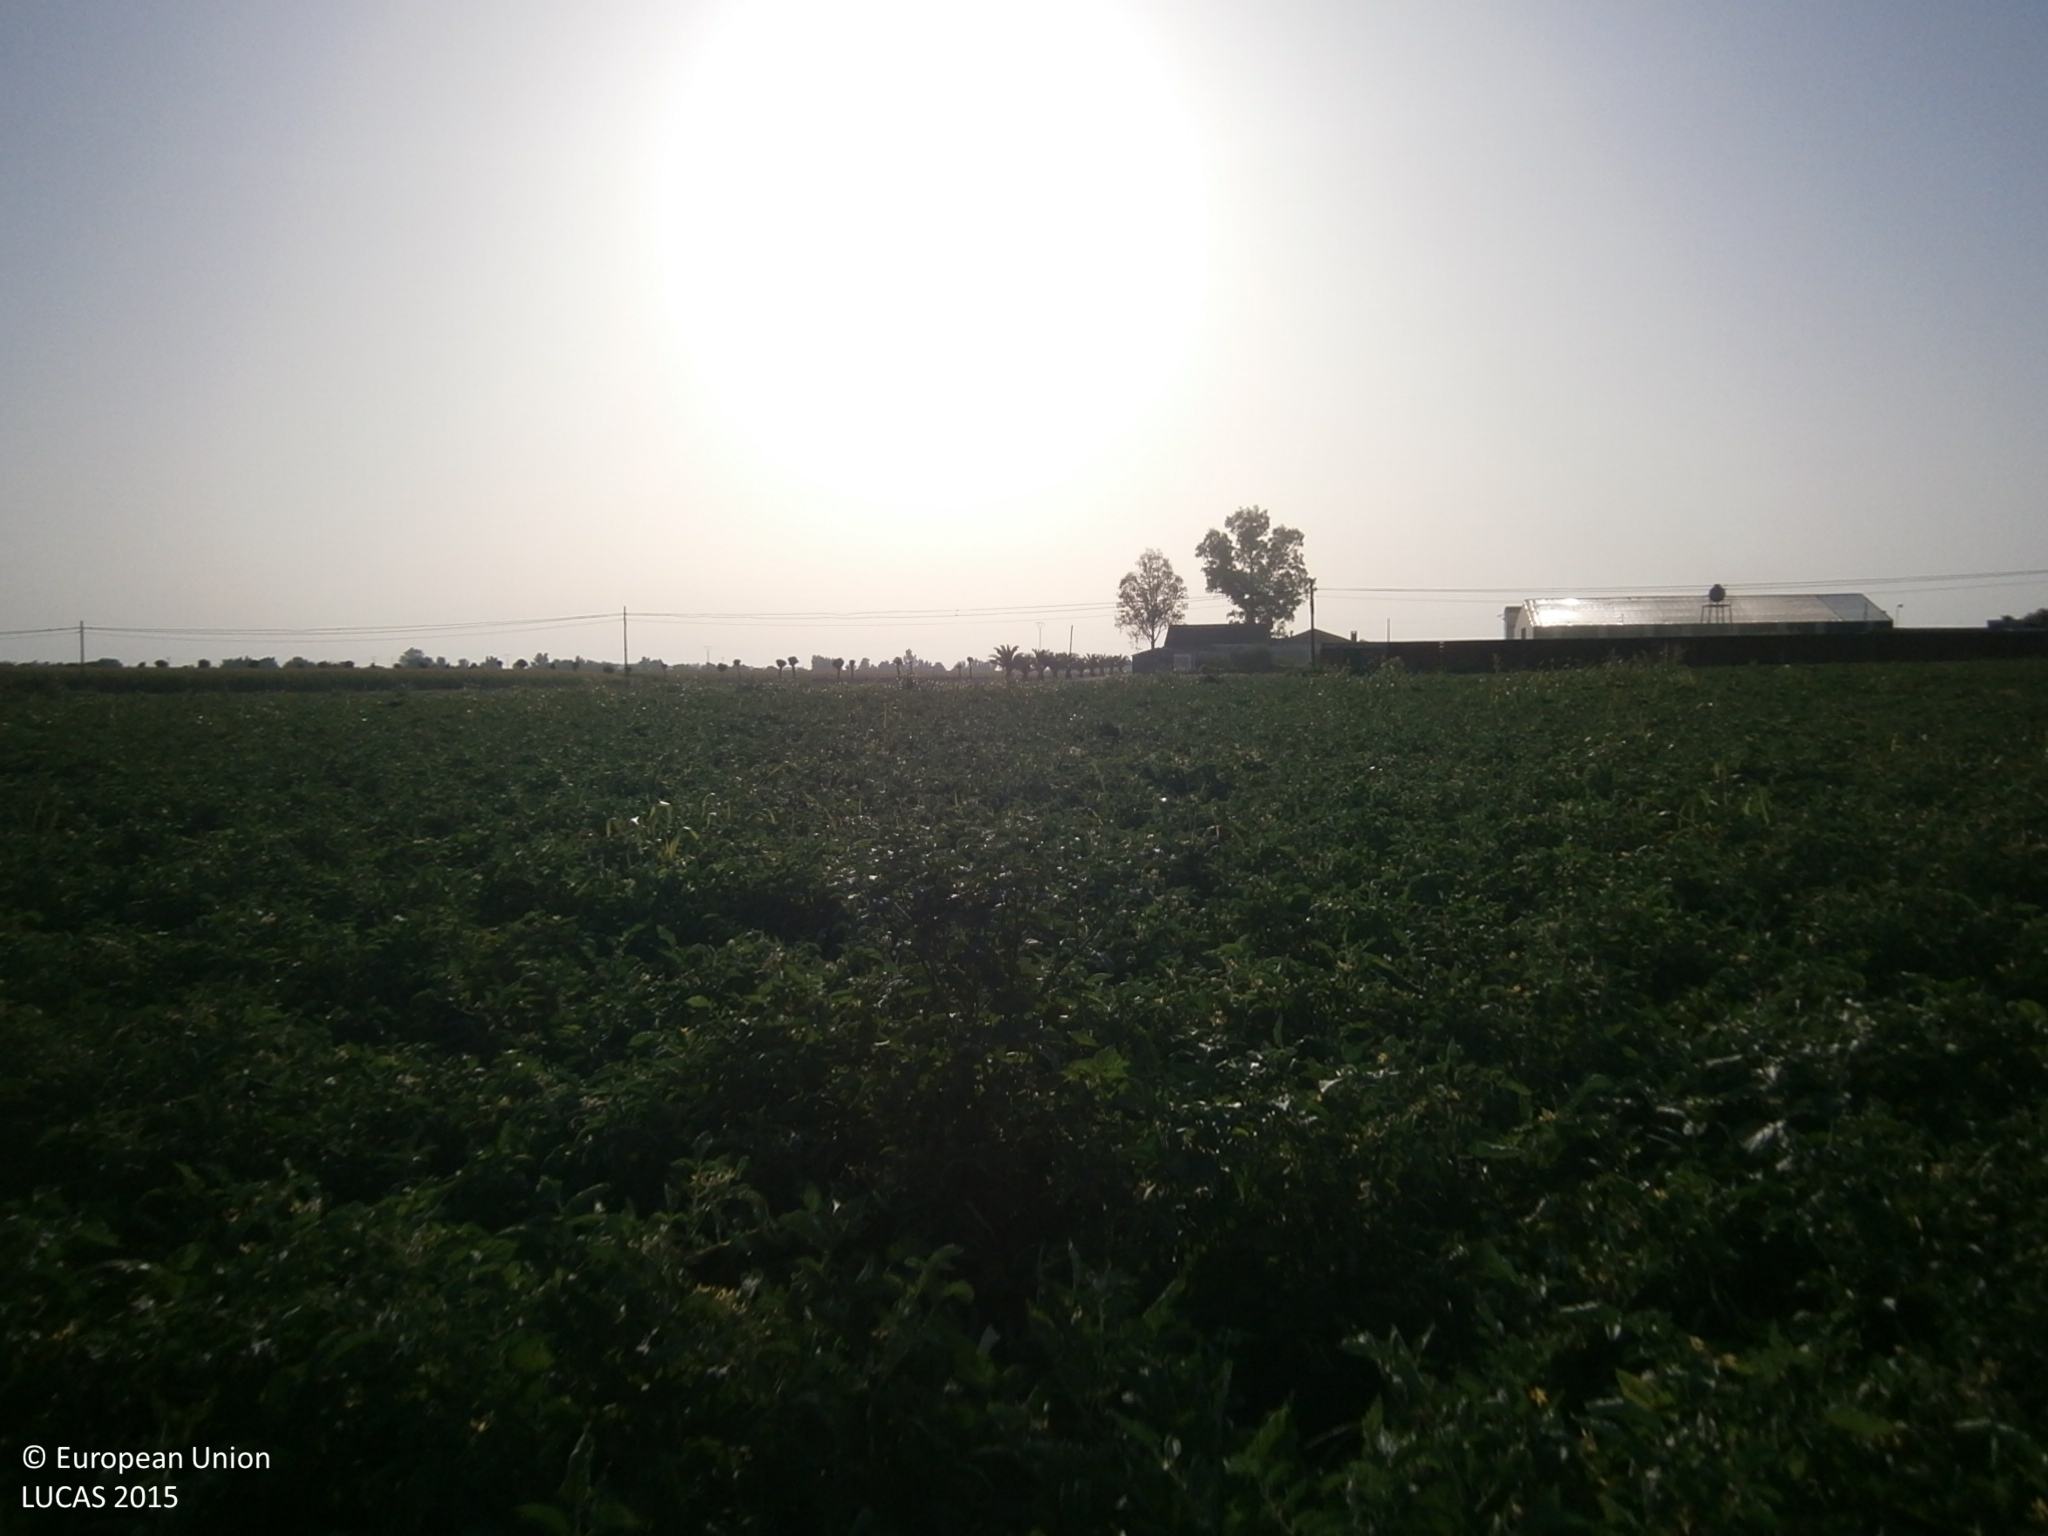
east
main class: Cropland
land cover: Tomatoes
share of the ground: > 75 %
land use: Agriculture (excluding fallow land and kitchen gardens)
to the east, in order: Tomatoes; Electric lines; Fences; Artificial constructions in urban areas
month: July
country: ES
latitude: 38.8956
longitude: -6.8197
